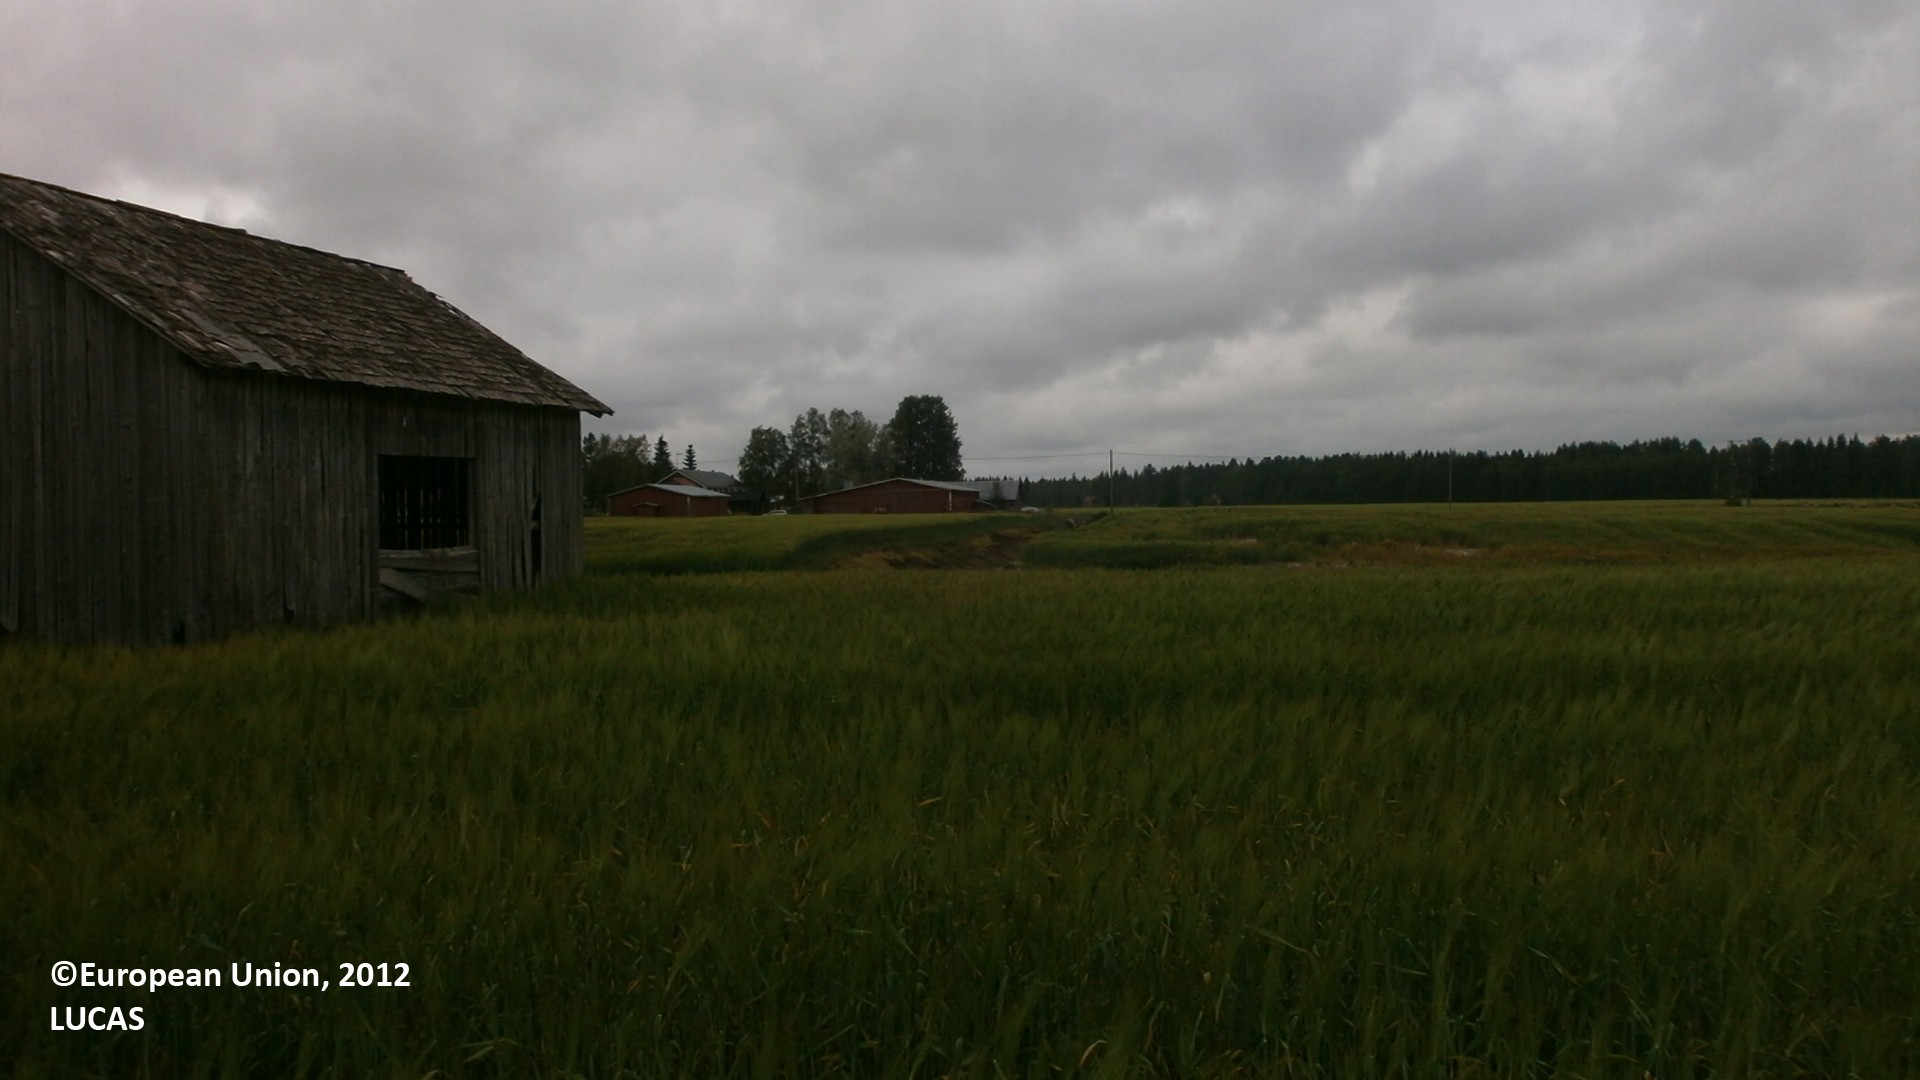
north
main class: Cropland
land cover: Barley
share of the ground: > 75 %
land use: Agriculture (excluding fallow land and kitchen gardens)
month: July
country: FI
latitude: 64.1997
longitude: 24.1725
